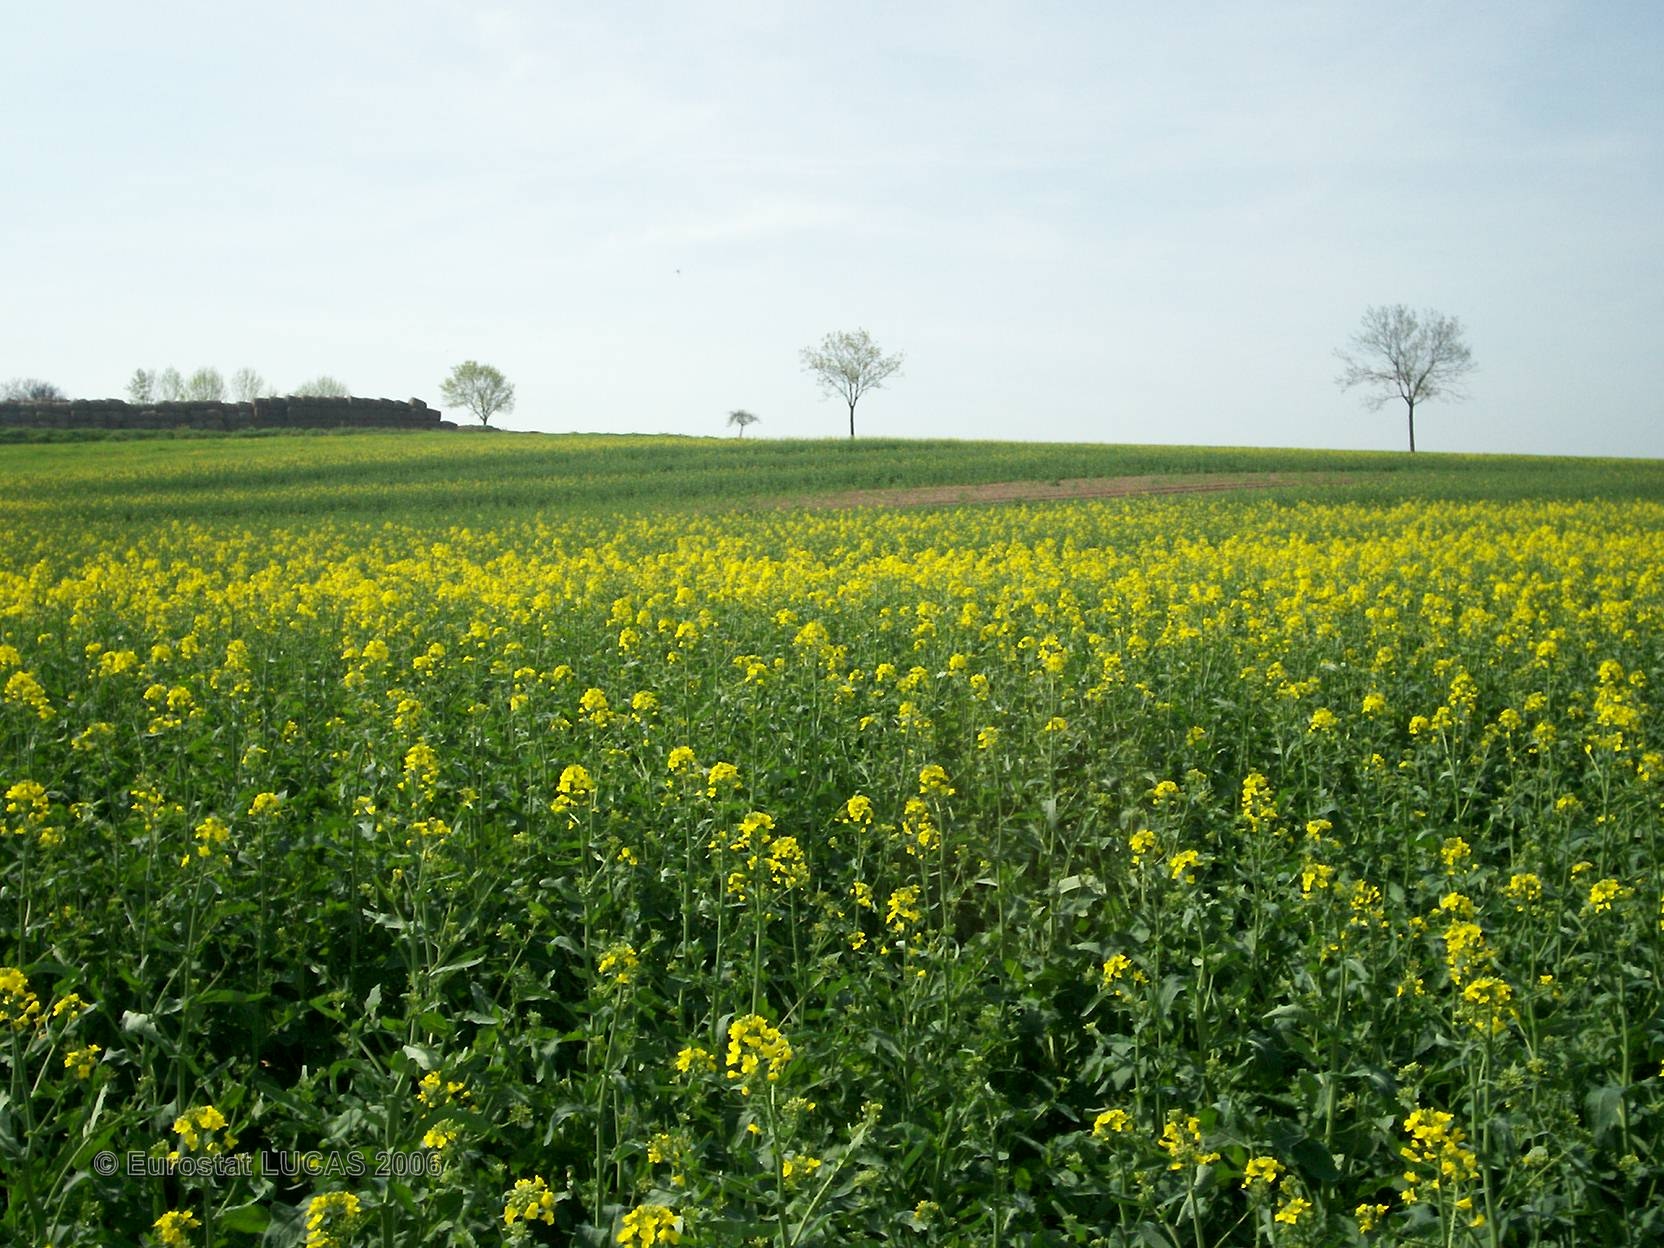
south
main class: Cropland
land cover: Rape and turnip rape
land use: Agriculture (excluding fallow land and kitchen gardens)
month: May
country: FR
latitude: 48.9550
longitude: 6.9277
